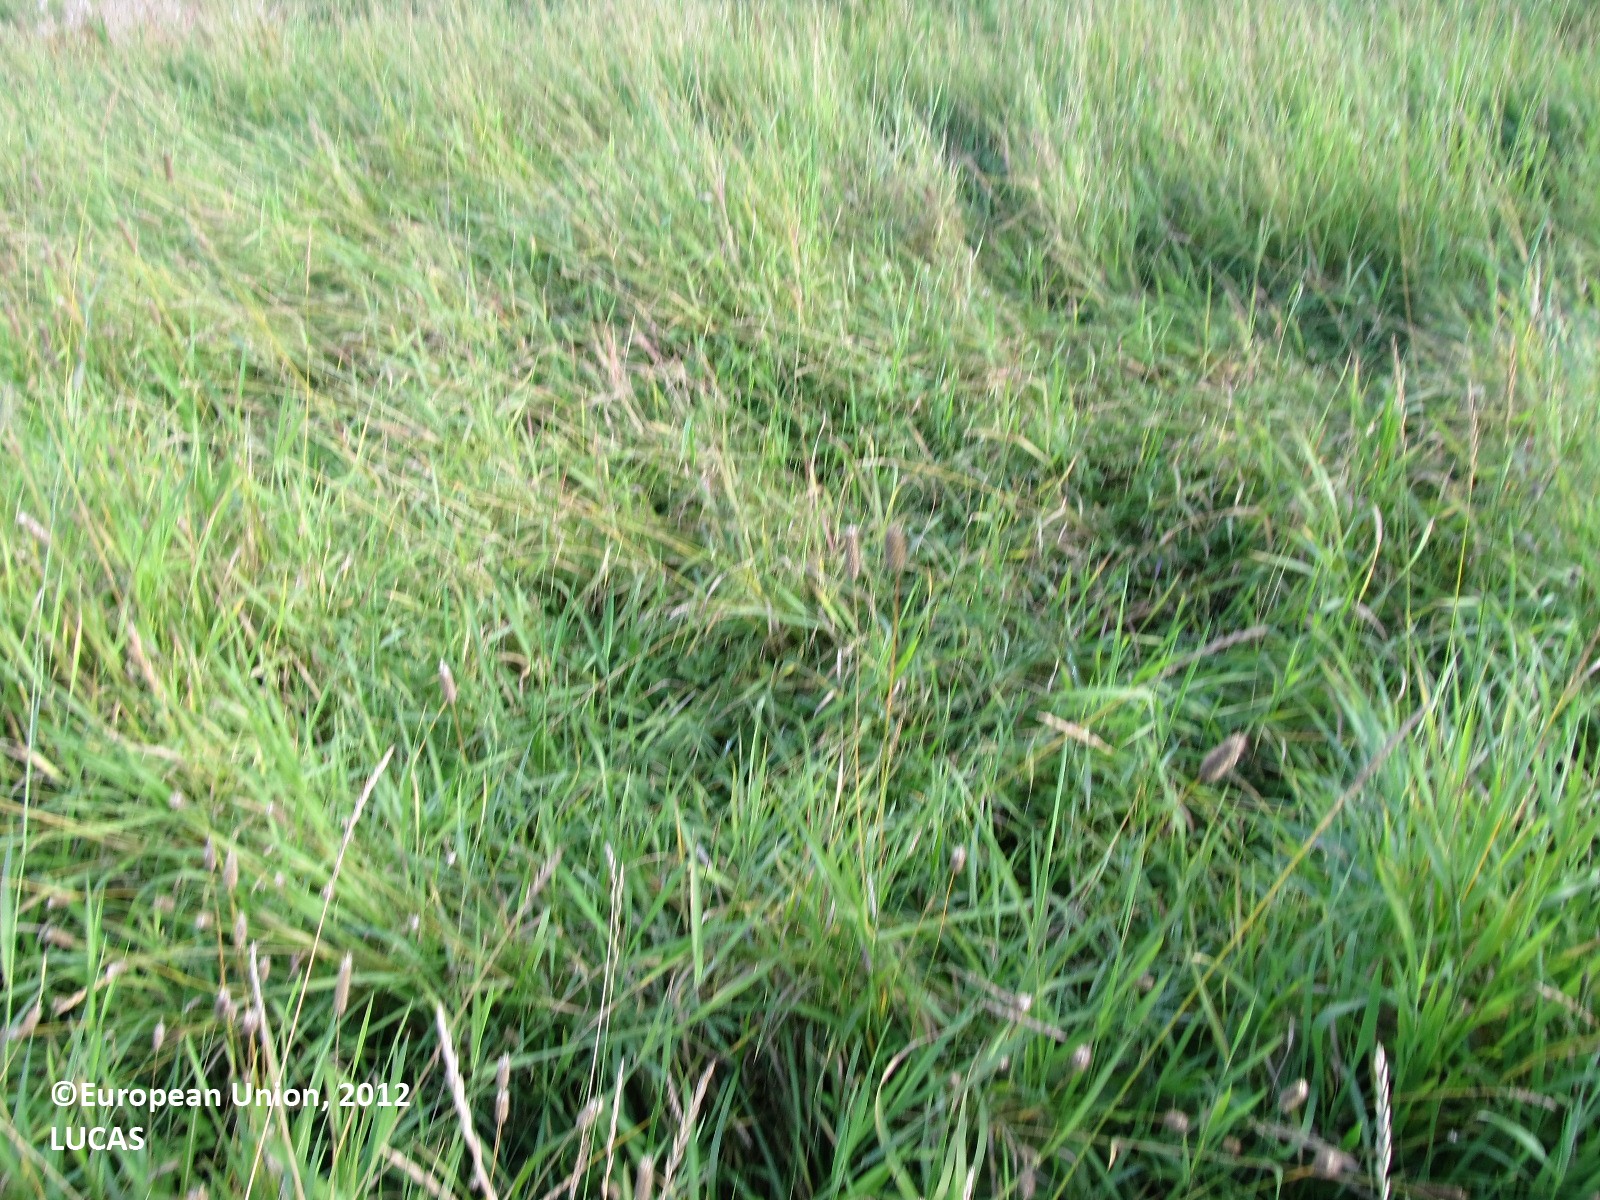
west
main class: Cropland
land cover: Temporary grasslands
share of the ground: > 75 %
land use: Agriculture (excluding fallow land and kitchen gardens)
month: September
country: FI
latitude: 63.2711
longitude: 28.3828
